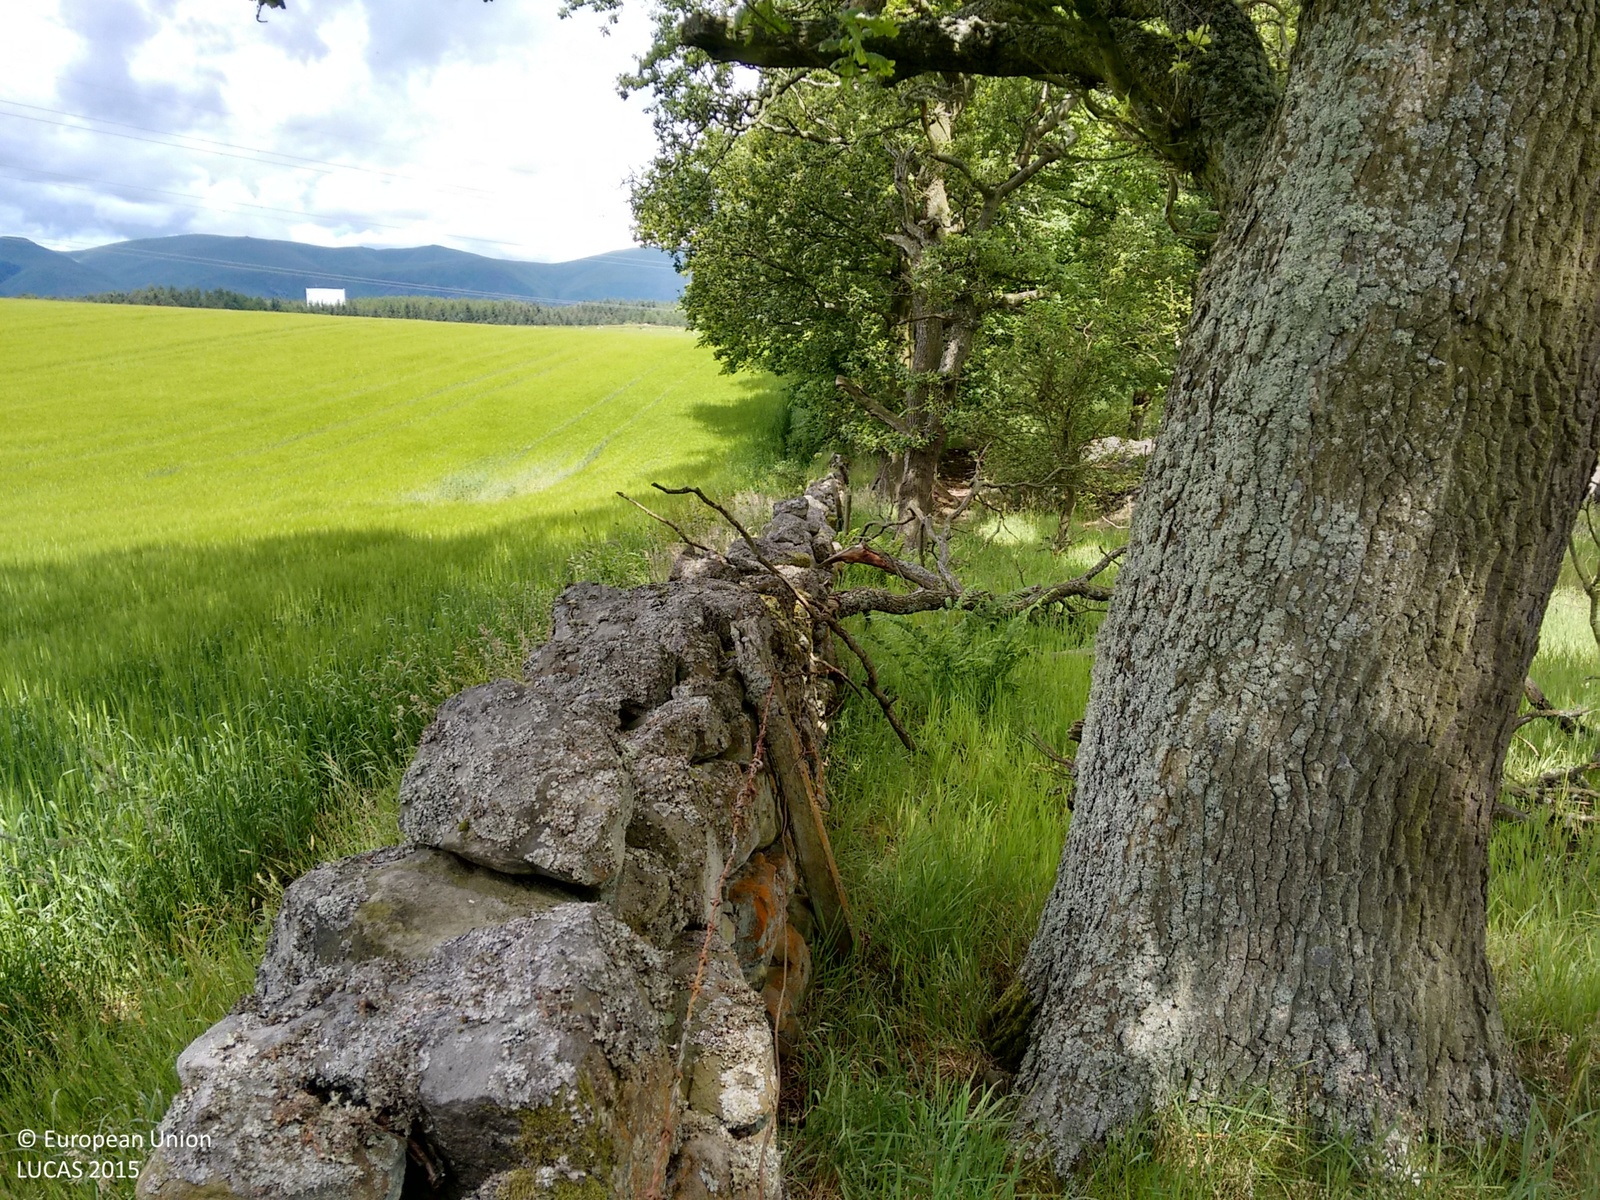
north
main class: Woodland
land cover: Pine dominated mixed woodland
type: exotic forest
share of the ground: > 75 %
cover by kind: coniferous forest trees 65 %, broadleaved forest trees 25 %, herbaceous plants 10 %
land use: Agriculture (excluding fallow land and kitchen gardens)
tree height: > 5 m
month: July
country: GB
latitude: 56.1060
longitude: -3.6994
